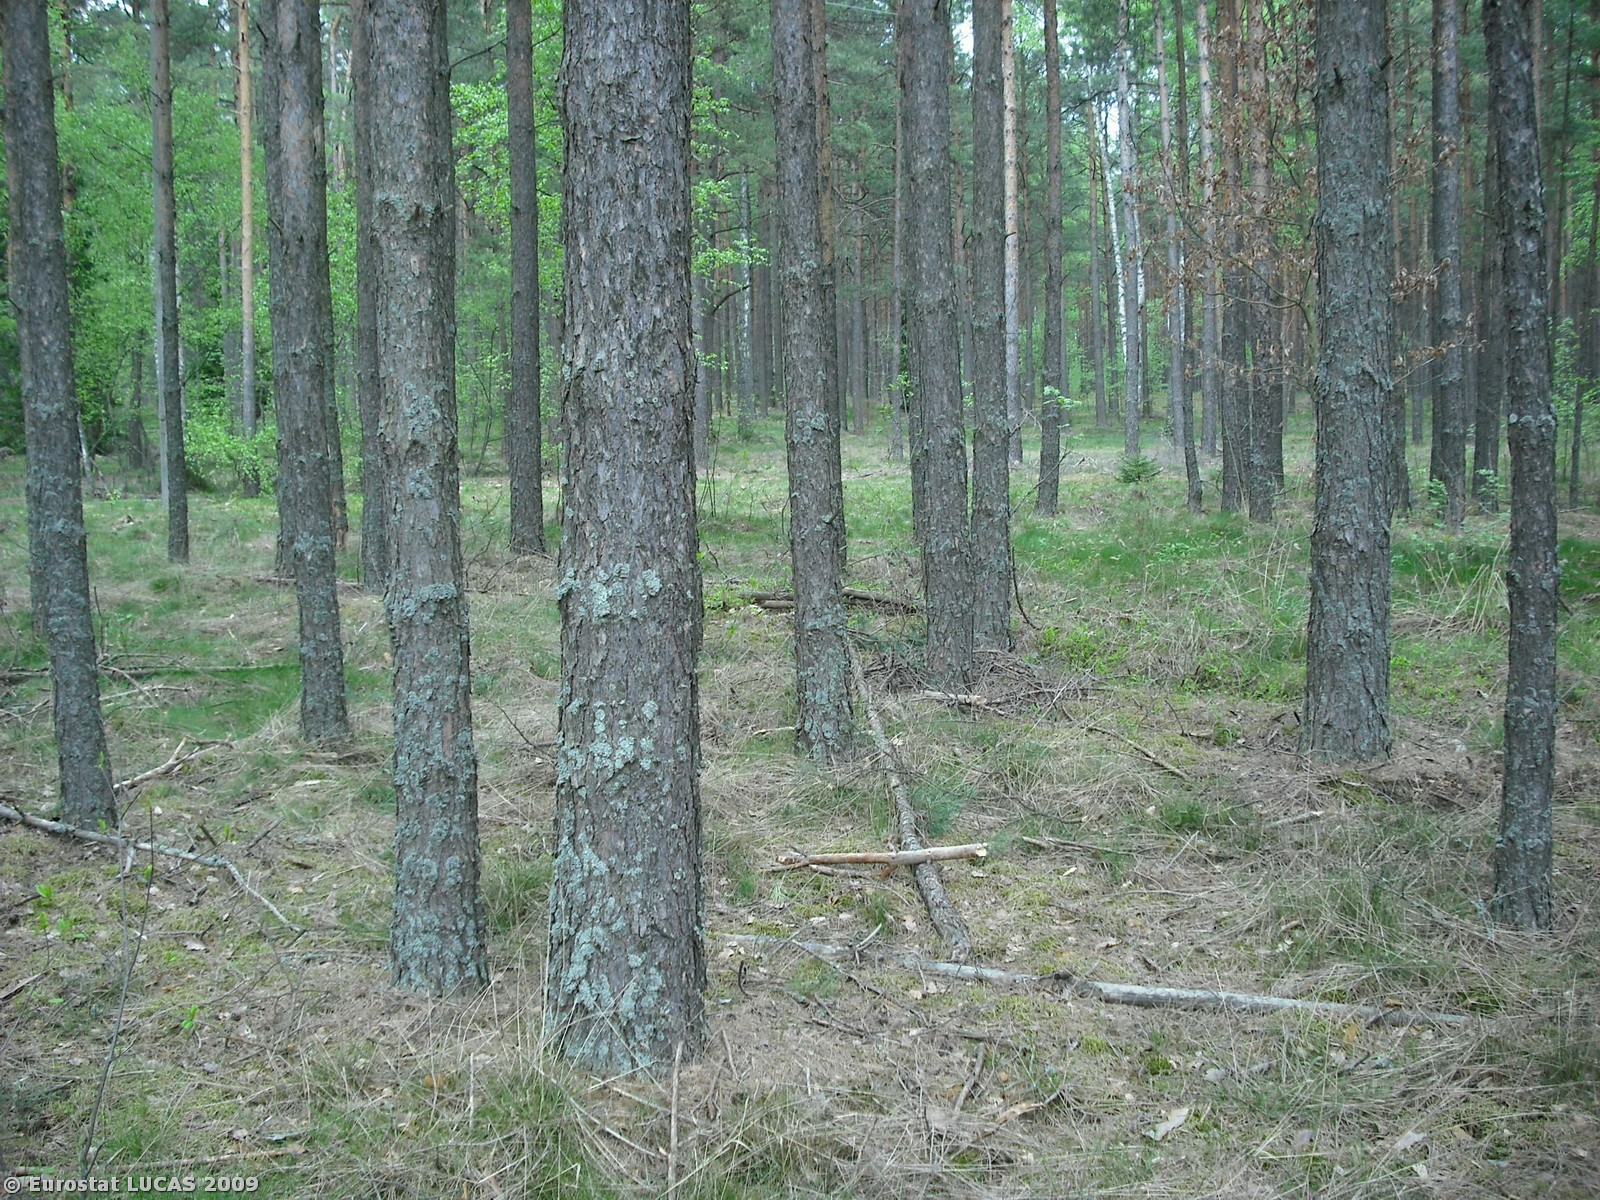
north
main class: Woodland
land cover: Mixed woodland
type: hemiboreal forest and nemoral coniferous forest and mixed broadleaved-coniferous forest
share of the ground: 50 - 75 %
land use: Forestry
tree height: > 5 m
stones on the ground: < 10 %
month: August
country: PL
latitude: 53.1039
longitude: 23.6036
